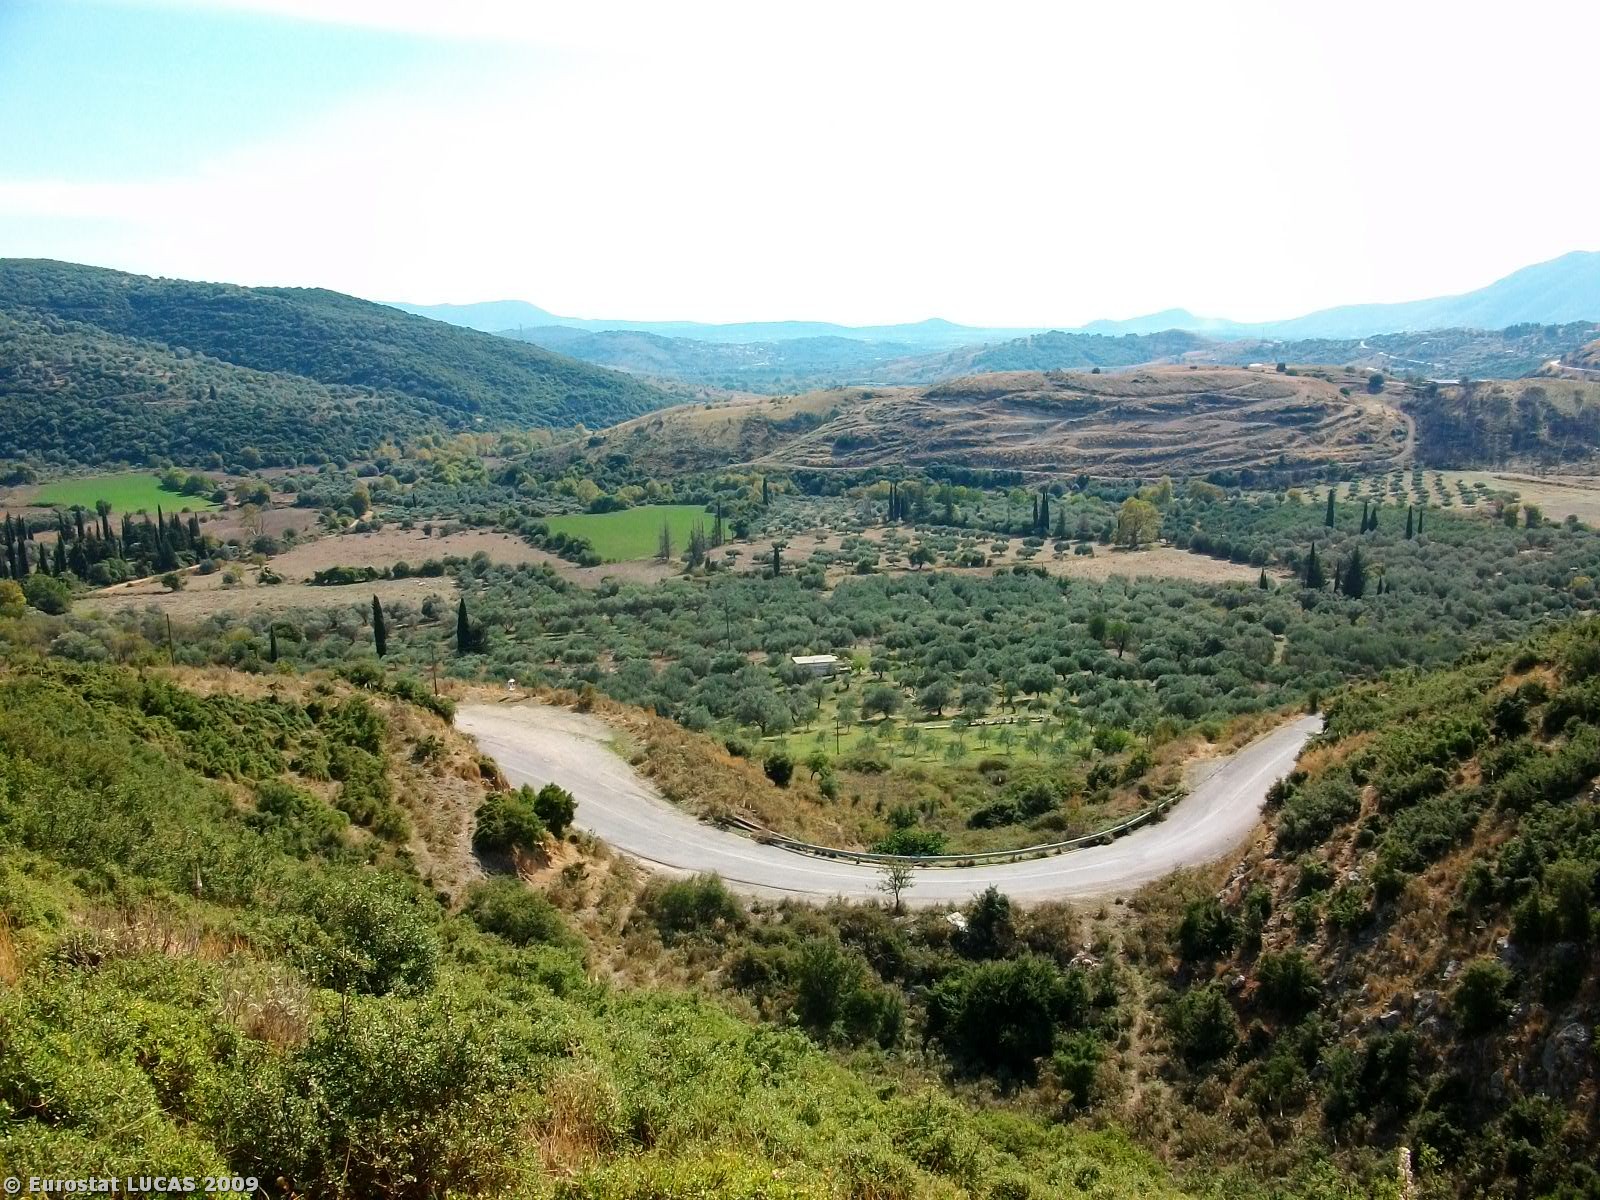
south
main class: Shrubland
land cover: Shrubland without tree cover
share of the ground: 50 - 75 %
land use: Agriculture (excluding fallow land and kitchen gardens)
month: September
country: GR
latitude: 39.6185
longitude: 20.2608
